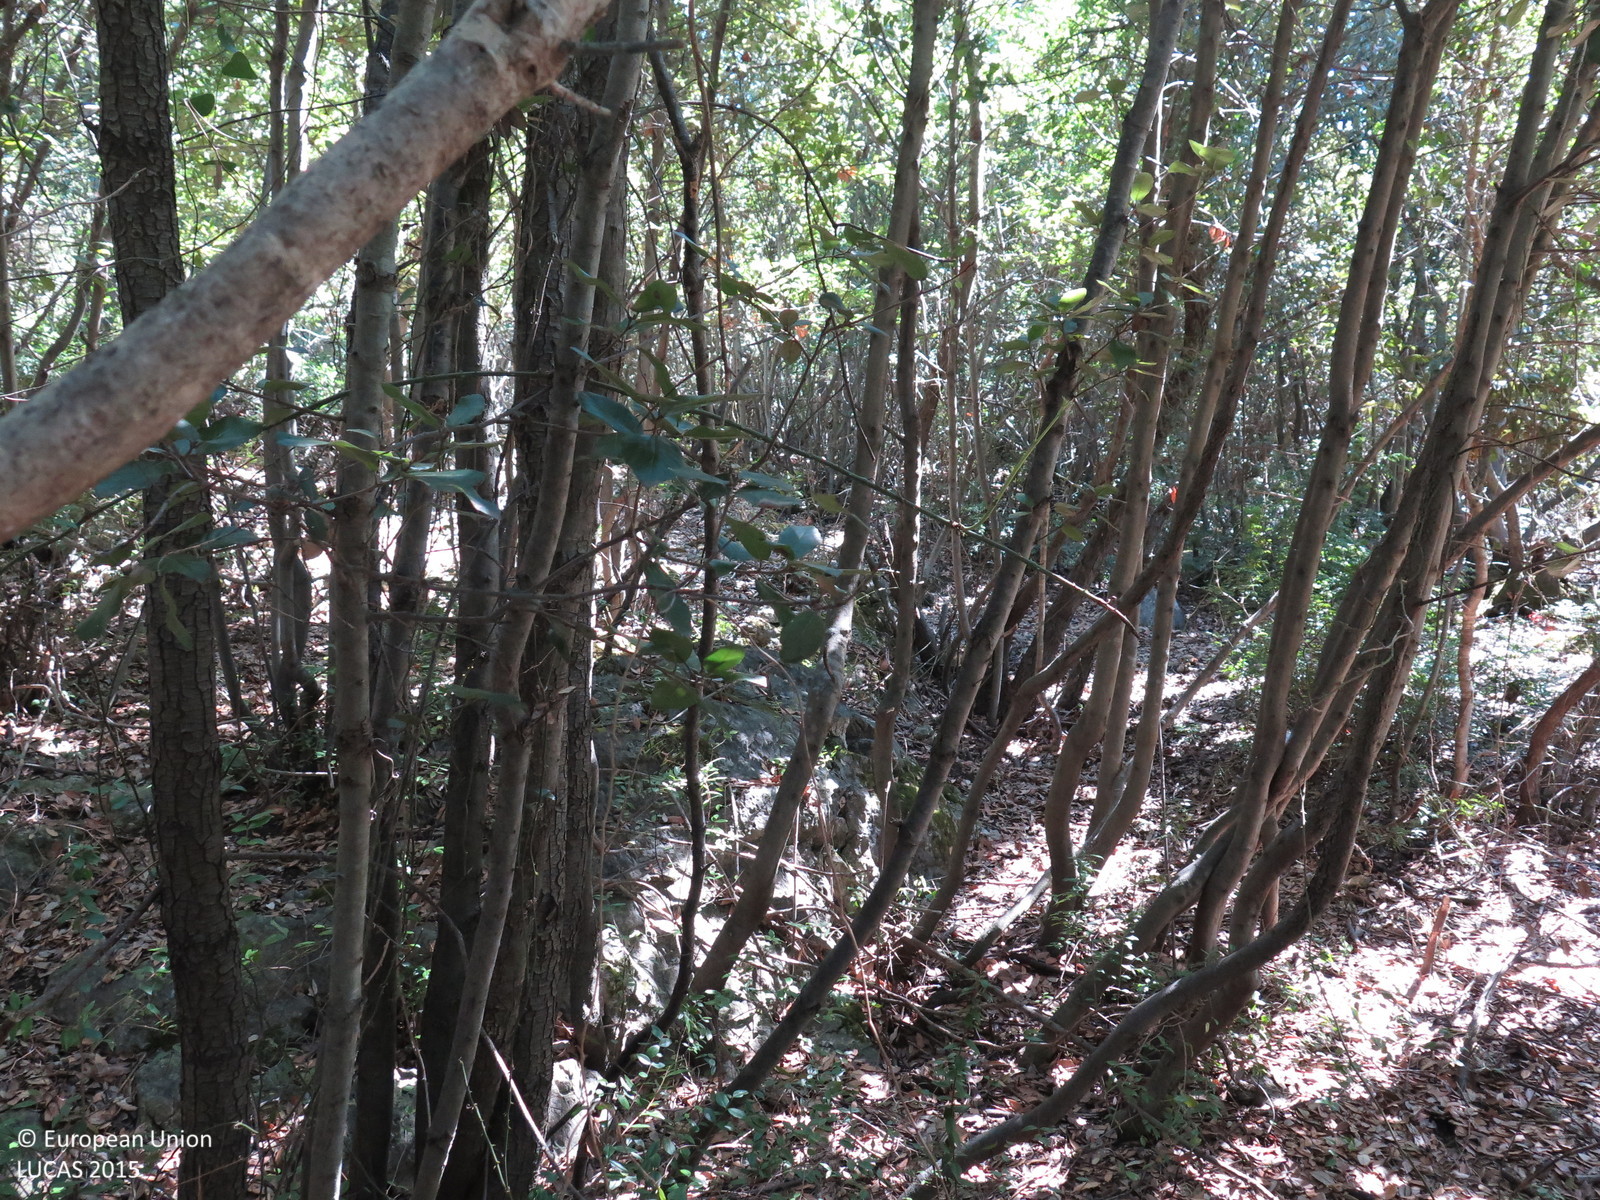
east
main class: Woodland
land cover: Broadleaved woodland
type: thermophilous deciduous forest
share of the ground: > 75 %
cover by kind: broadleaved forest trees 90 %, shrubs 5 %, herbaceous plants 5 %
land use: Semi-natural and natural areas not in use
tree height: < 5 m
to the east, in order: Broadleaved woodland; Dry stone walls; Broadleaved woodland; Dry stone walls; Broadleaved woodland; Electric lines; Shrubland without tree cover; Broadleaved woodland
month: September
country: HR
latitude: 44.6325
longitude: 14.4935
